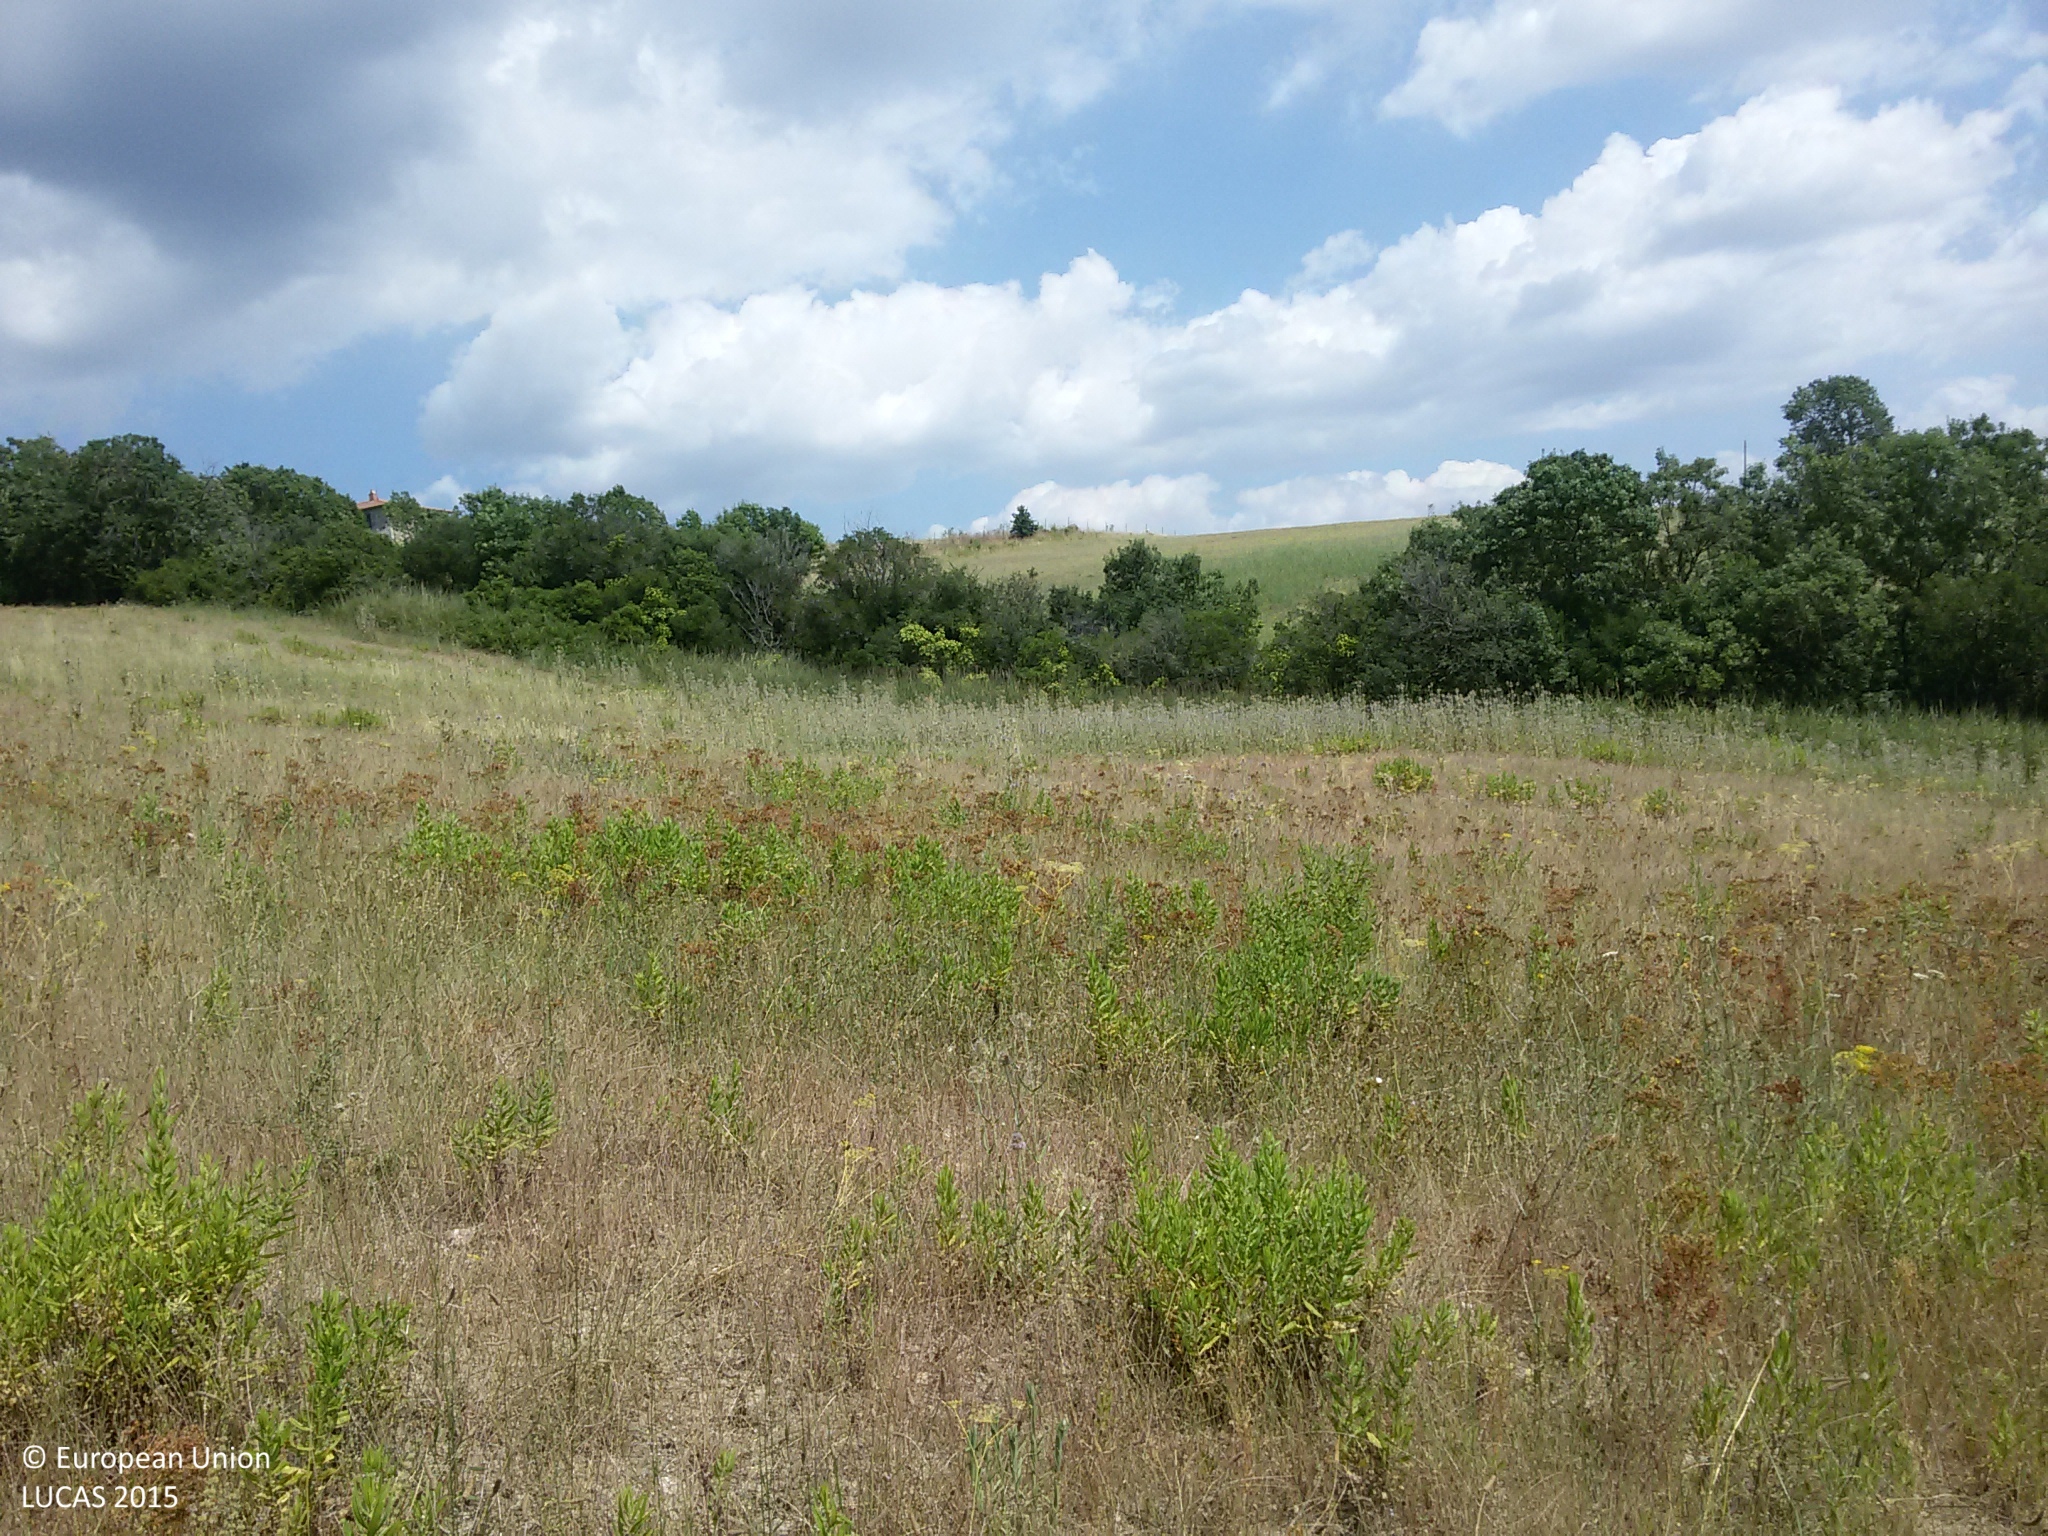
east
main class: Grassland
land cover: Grassland without tree/shrub cover
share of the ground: 50 - 75 %
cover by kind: herbaceous plants 90 %, consolidated bare surface 5 %, unconsolidated bare surface 5 %
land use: Agriculture (excluding fallow land and kitchen gardens)
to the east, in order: Grassland without tree/shrub cover; Ditches and canals; Grassland without tree/shrub cover; Ditches and canals; Abandoned hedges; Rivers and streams; Abandoned hedges; Grassland without tree/shrub cover; Fences; Lines of trees; Grassland without tree/shrub cover; Single bushes/trees; Artificial constructions in urban areas; Single bushes/trees; Olive groves; Grassland without tree/shrub cover; Fences; Shruby margins
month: July
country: IT
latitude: 42.7156
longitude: 11.4726
